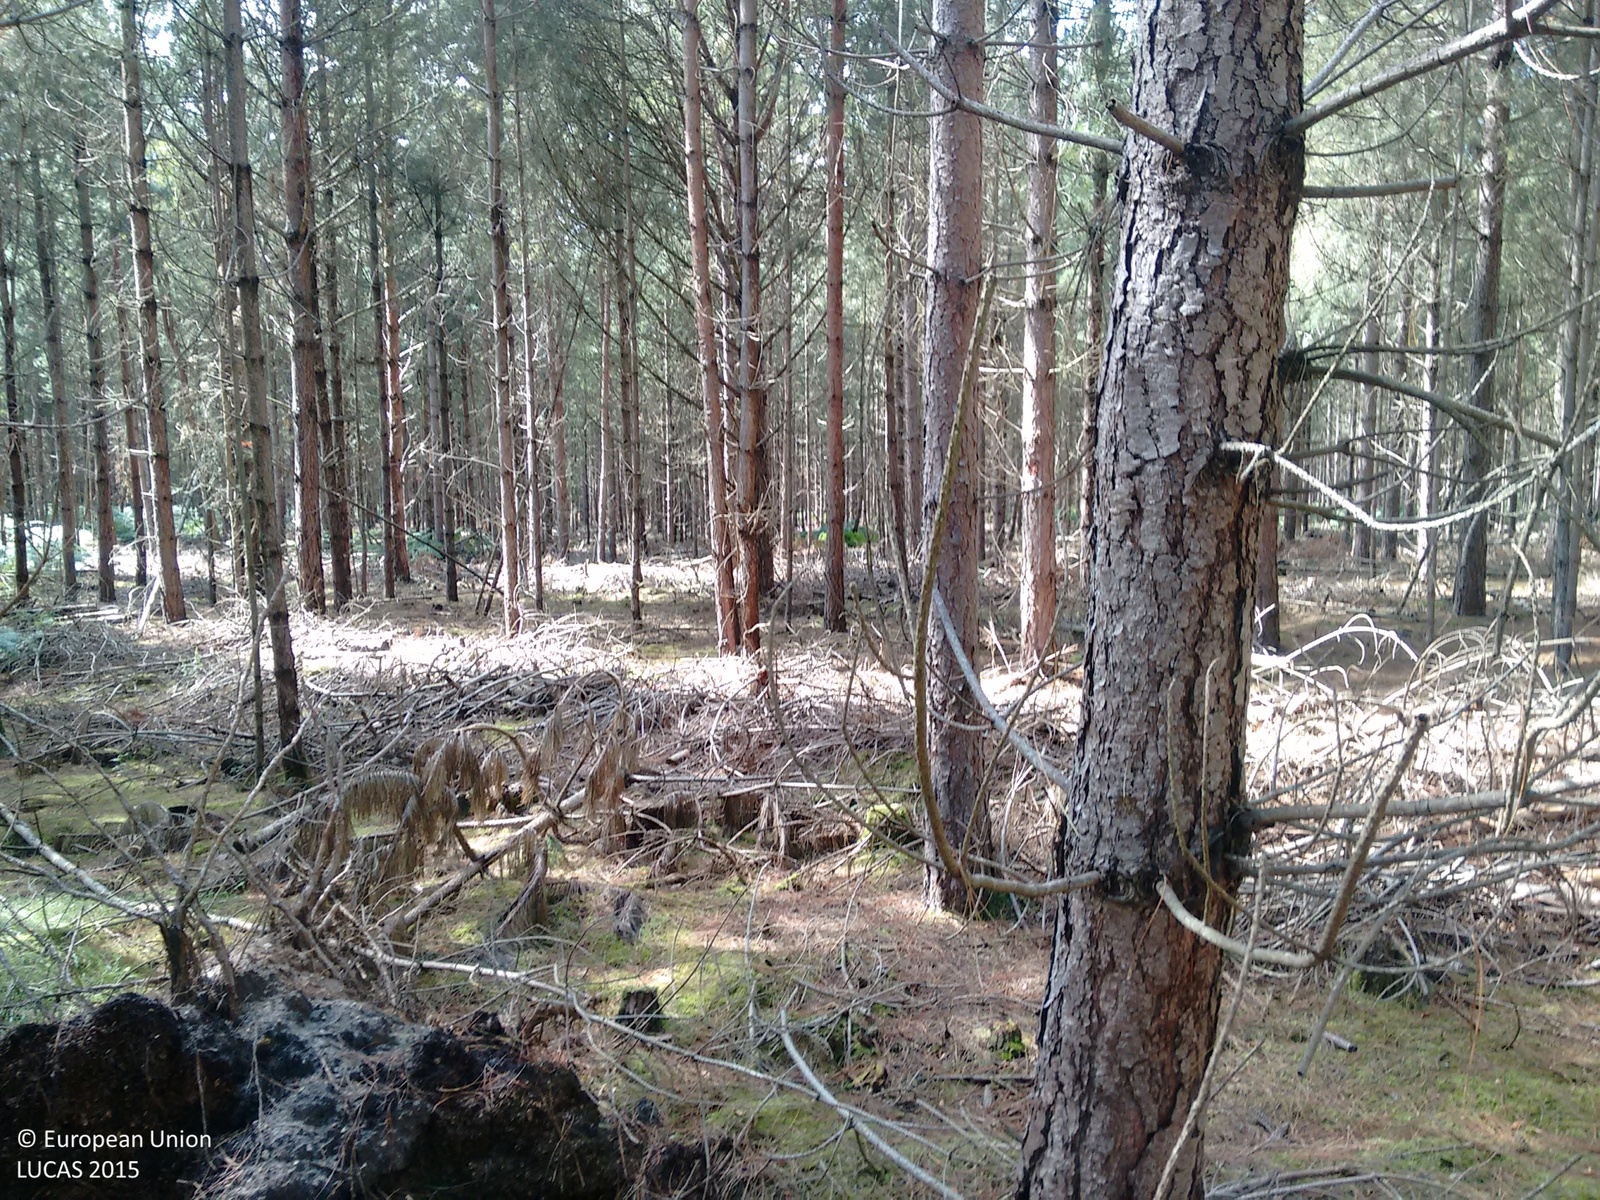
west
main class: Woodland
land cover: Pine dominated coniferous woodland
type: exotic forest
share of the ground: > 75 %
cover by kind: coniferous forest trees 90 %, herbaceous plants 10 %
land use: Forestry
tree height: > 5 m
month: August
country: GB
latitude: 52.0862
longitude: 1.4429
